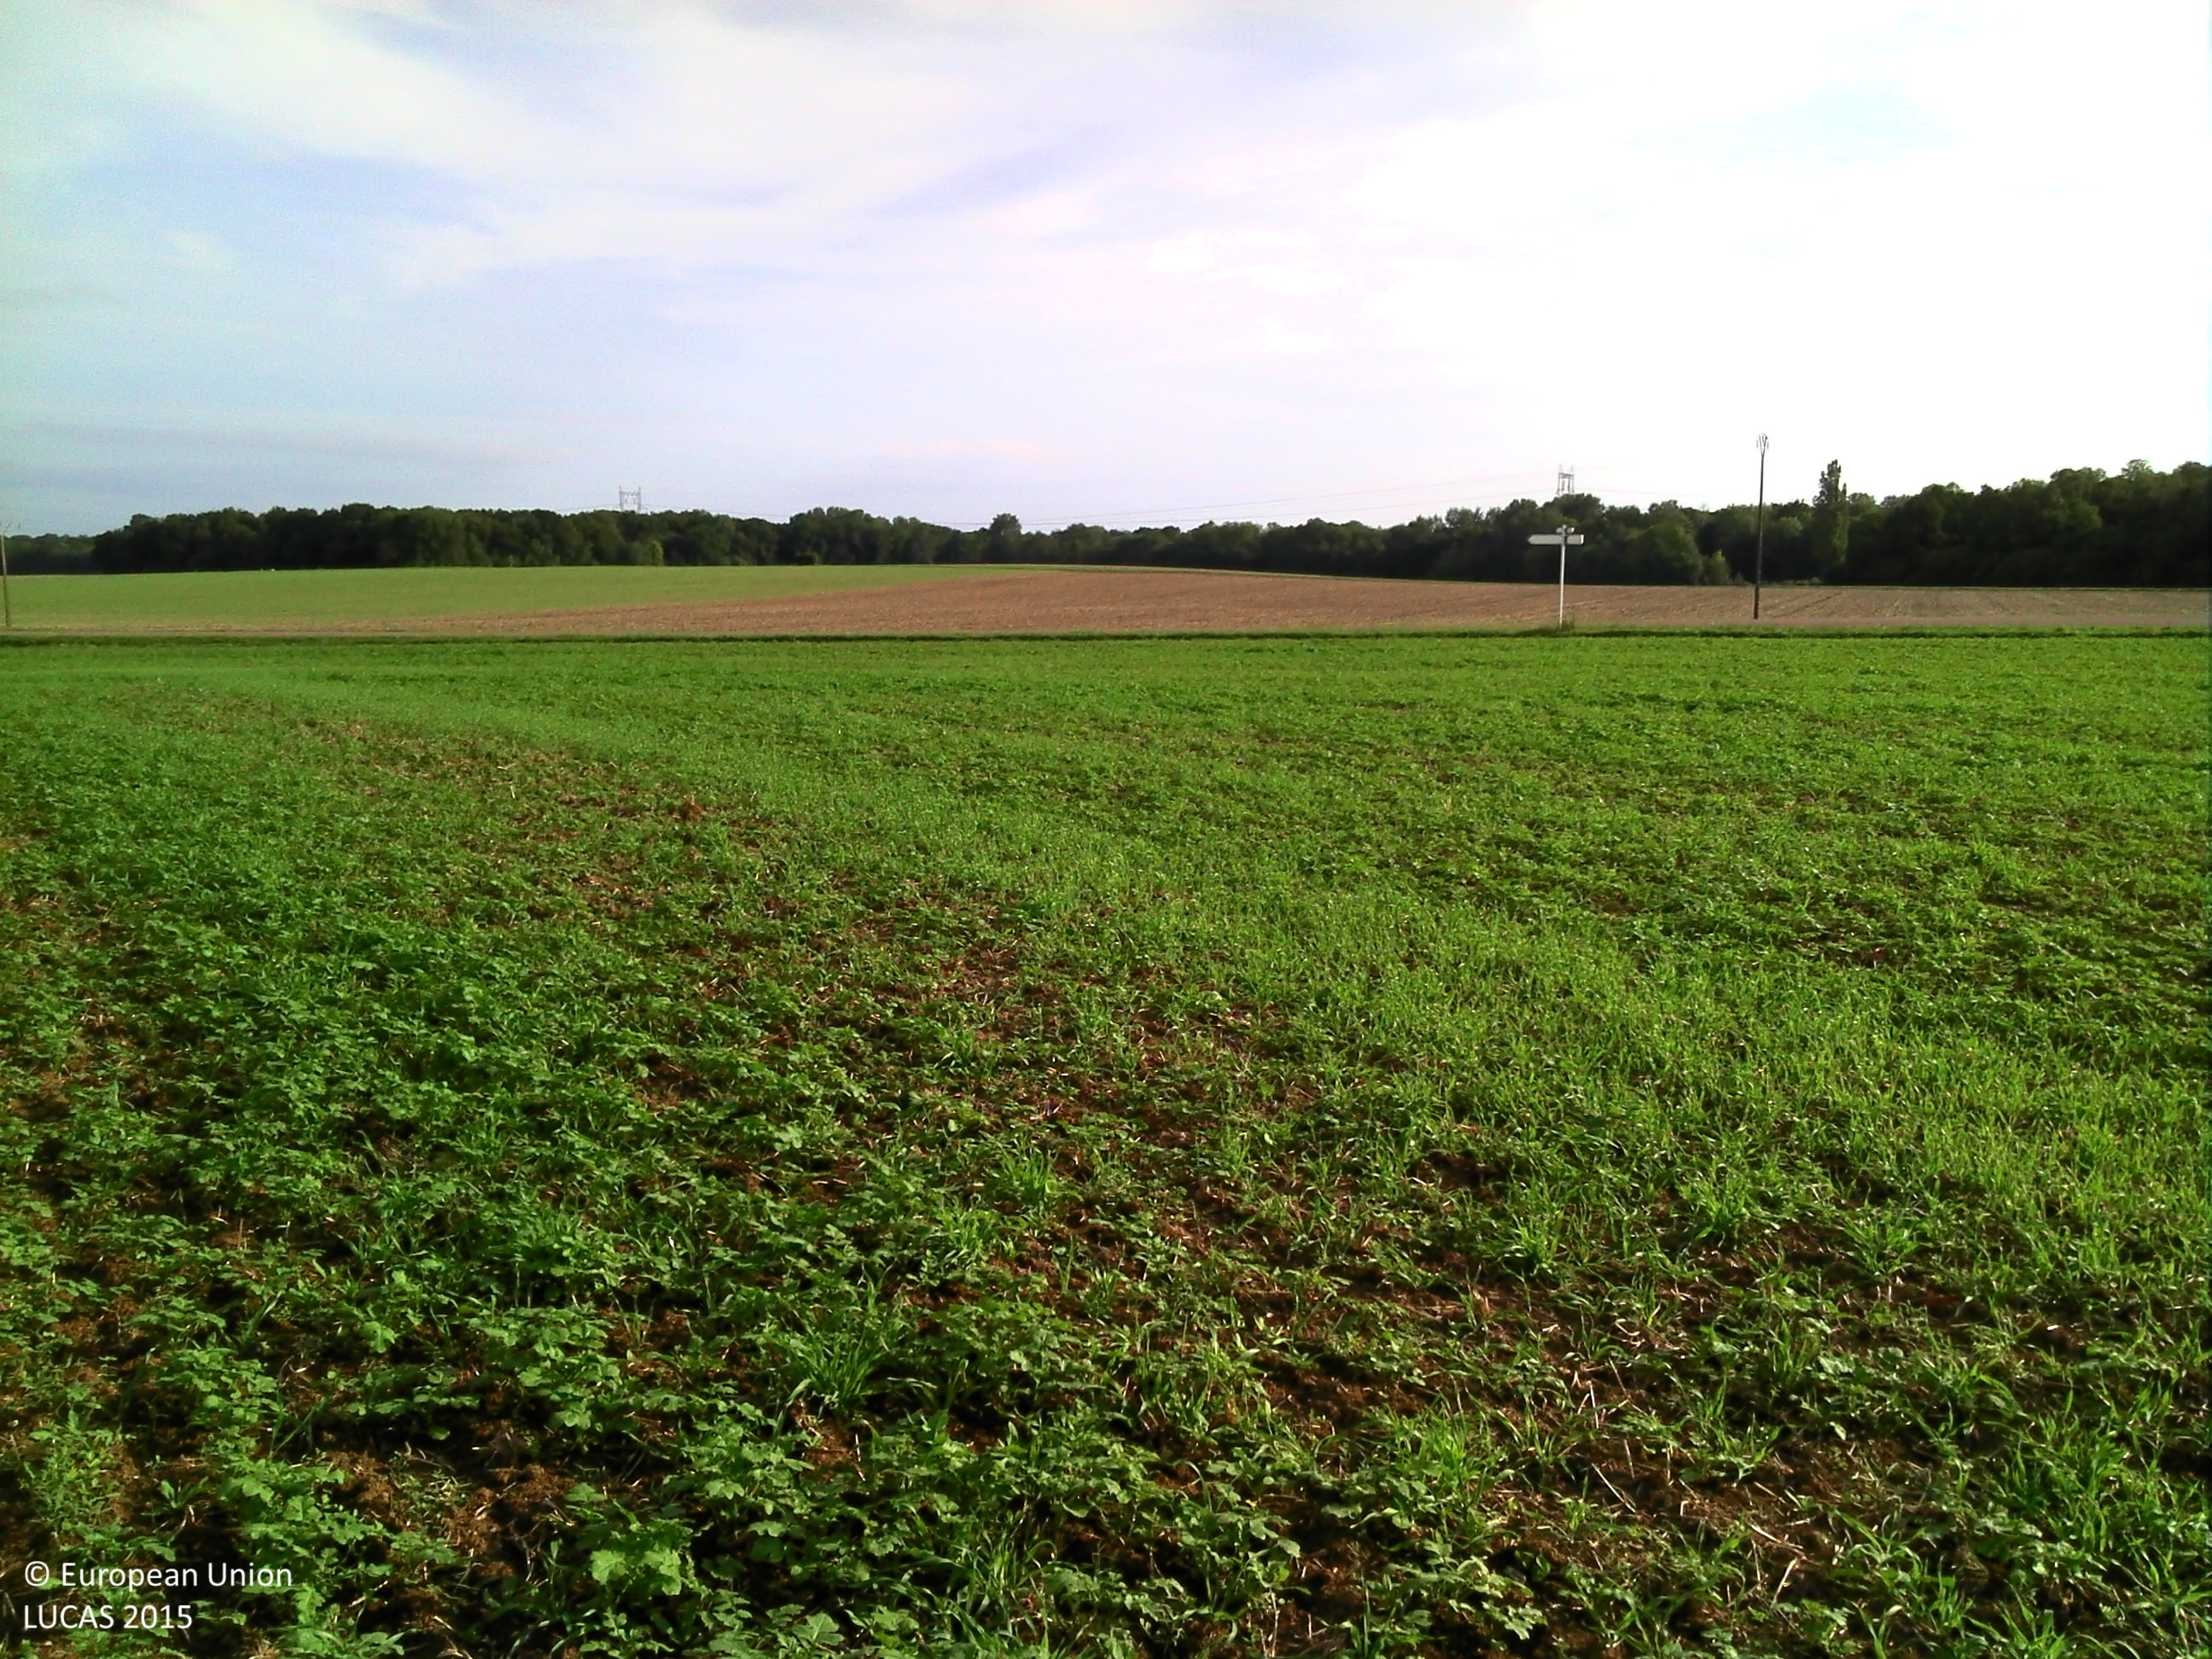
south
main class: Cropland
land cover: Other fibre and oleaginous crops
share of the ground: > 75 %
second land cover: Other leguminous and mixtures for fodder
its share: < 10 %
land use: Agriculture (excluding fallow land and kitchen gardens)
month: September
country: FR
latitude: 48.5238
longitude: 4.5950
